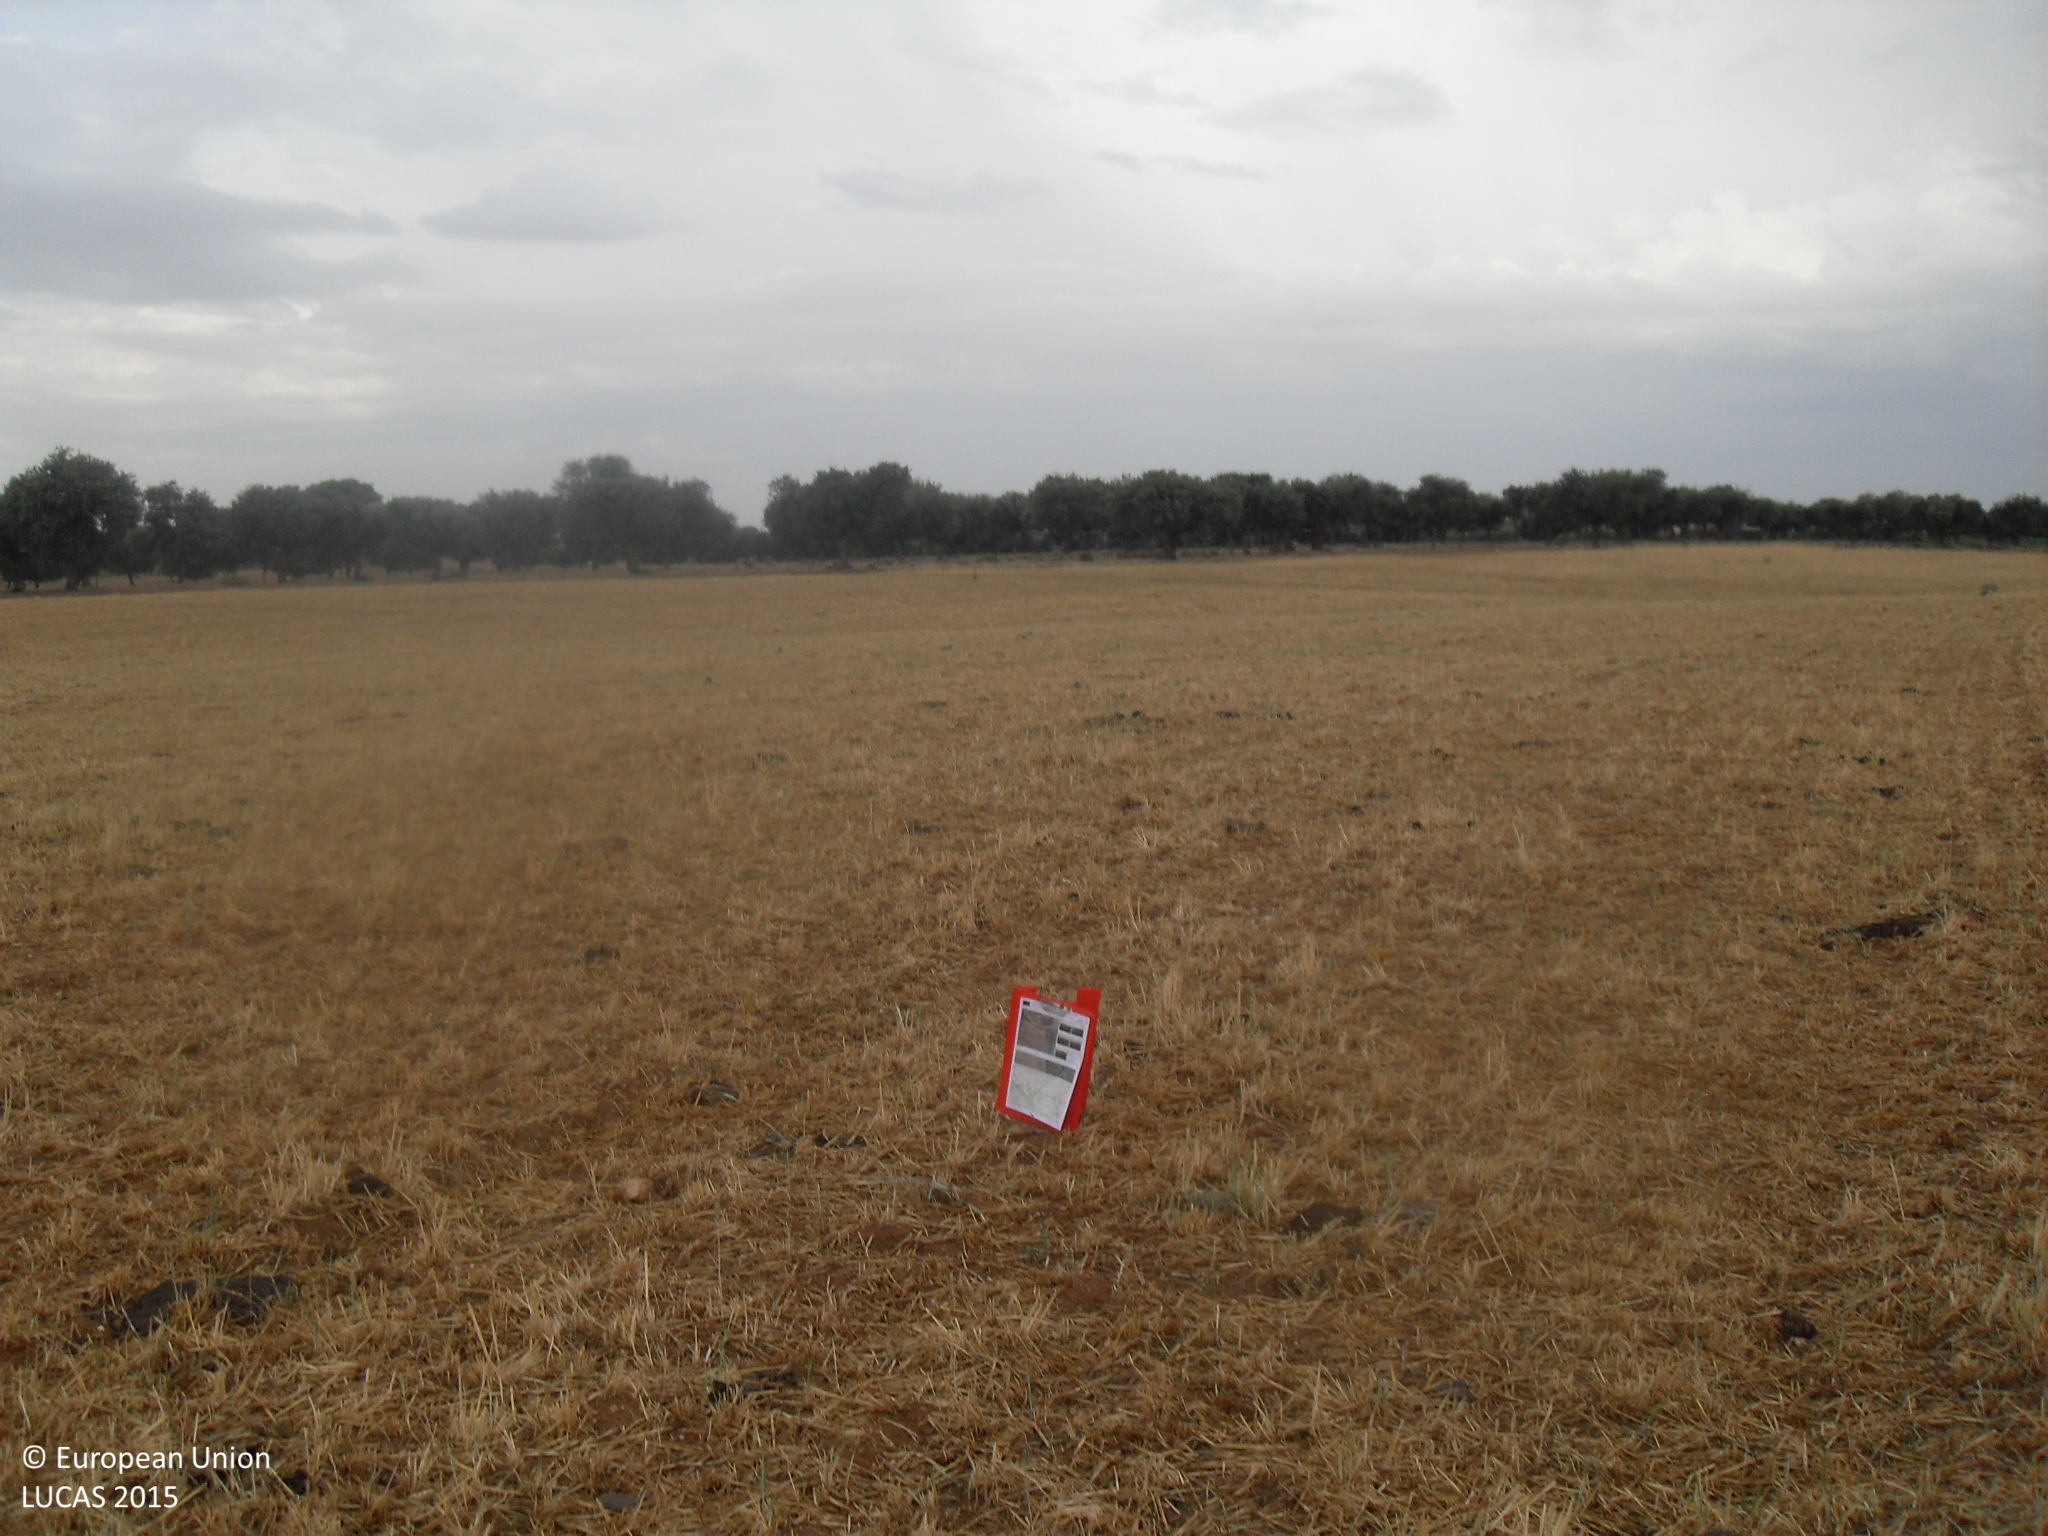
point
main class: Cropland
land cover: Rye
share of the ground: 10 - 25 %
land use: Agriculture (excluding fallow land and kitchen gardens)
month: June
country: ES
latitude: 41.0494
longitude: -5.7247
